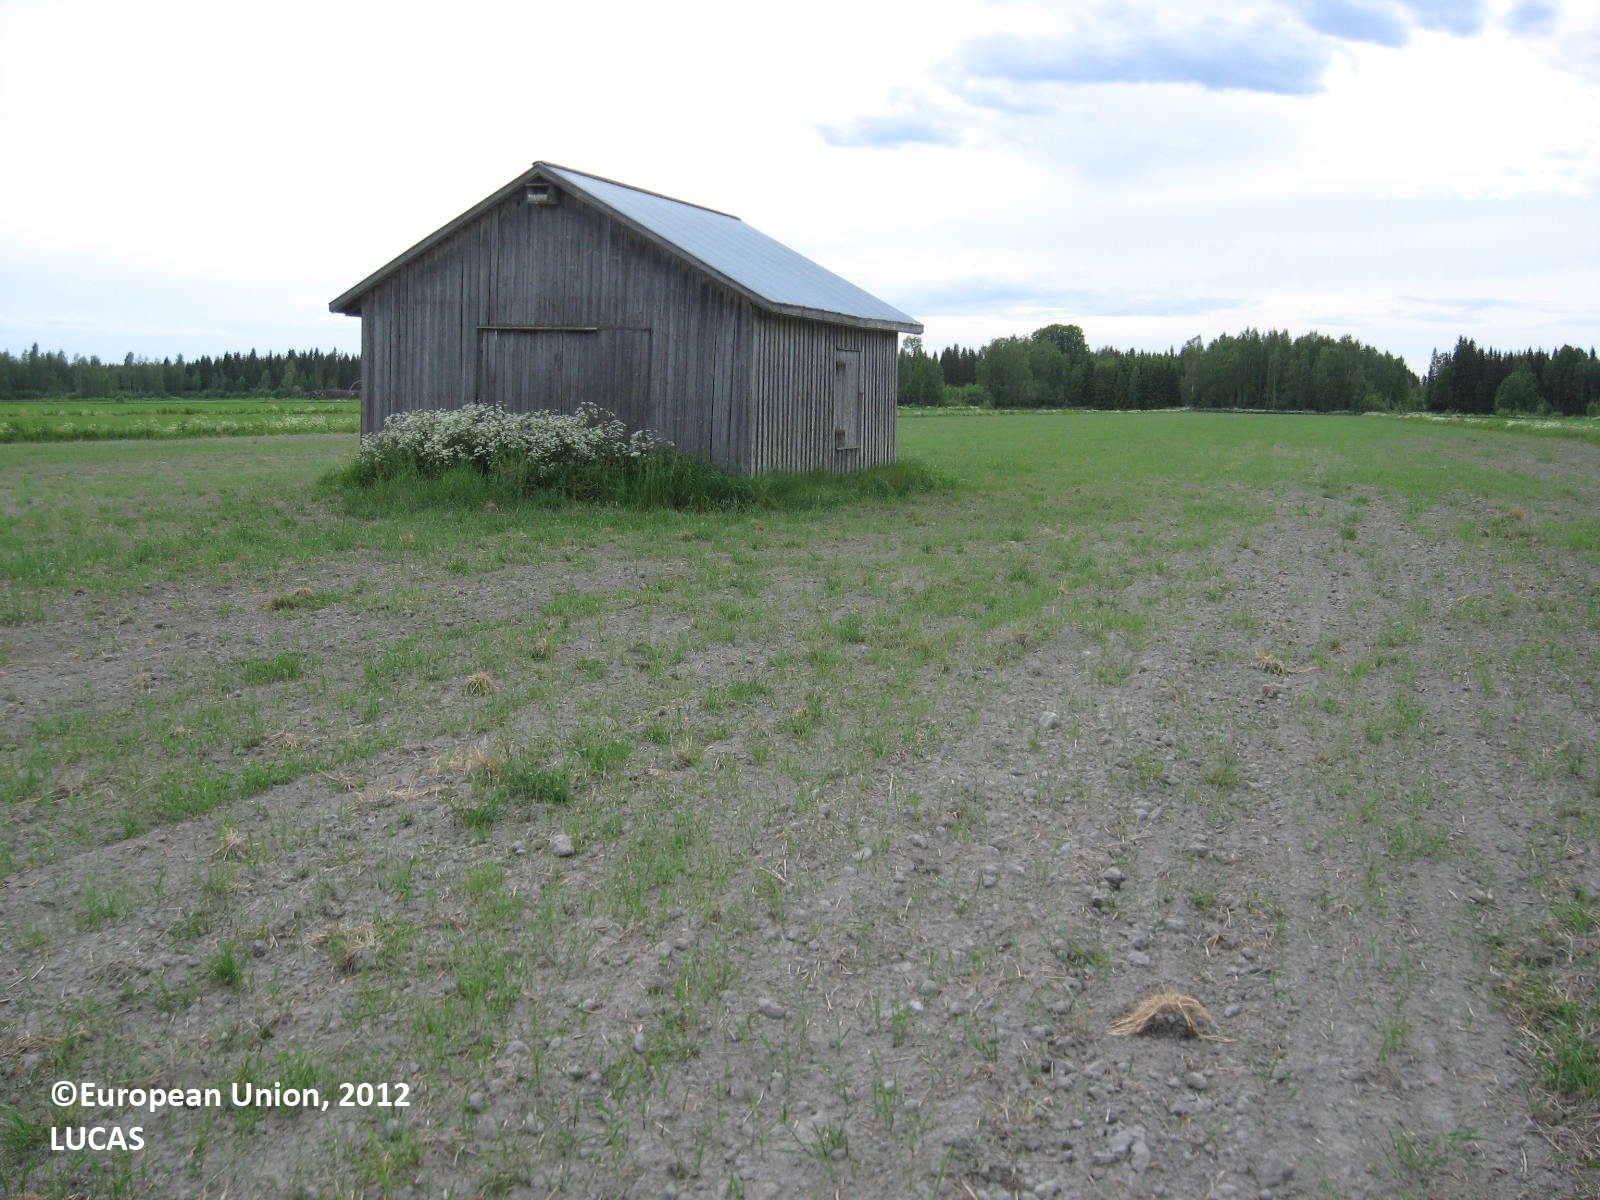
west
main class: Grassland
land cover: Spontaneously vegetated surfaces
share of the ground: 10 - 25 %
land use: Fallow land
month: June
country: FI
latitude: 62.6632
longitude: 21.4999
